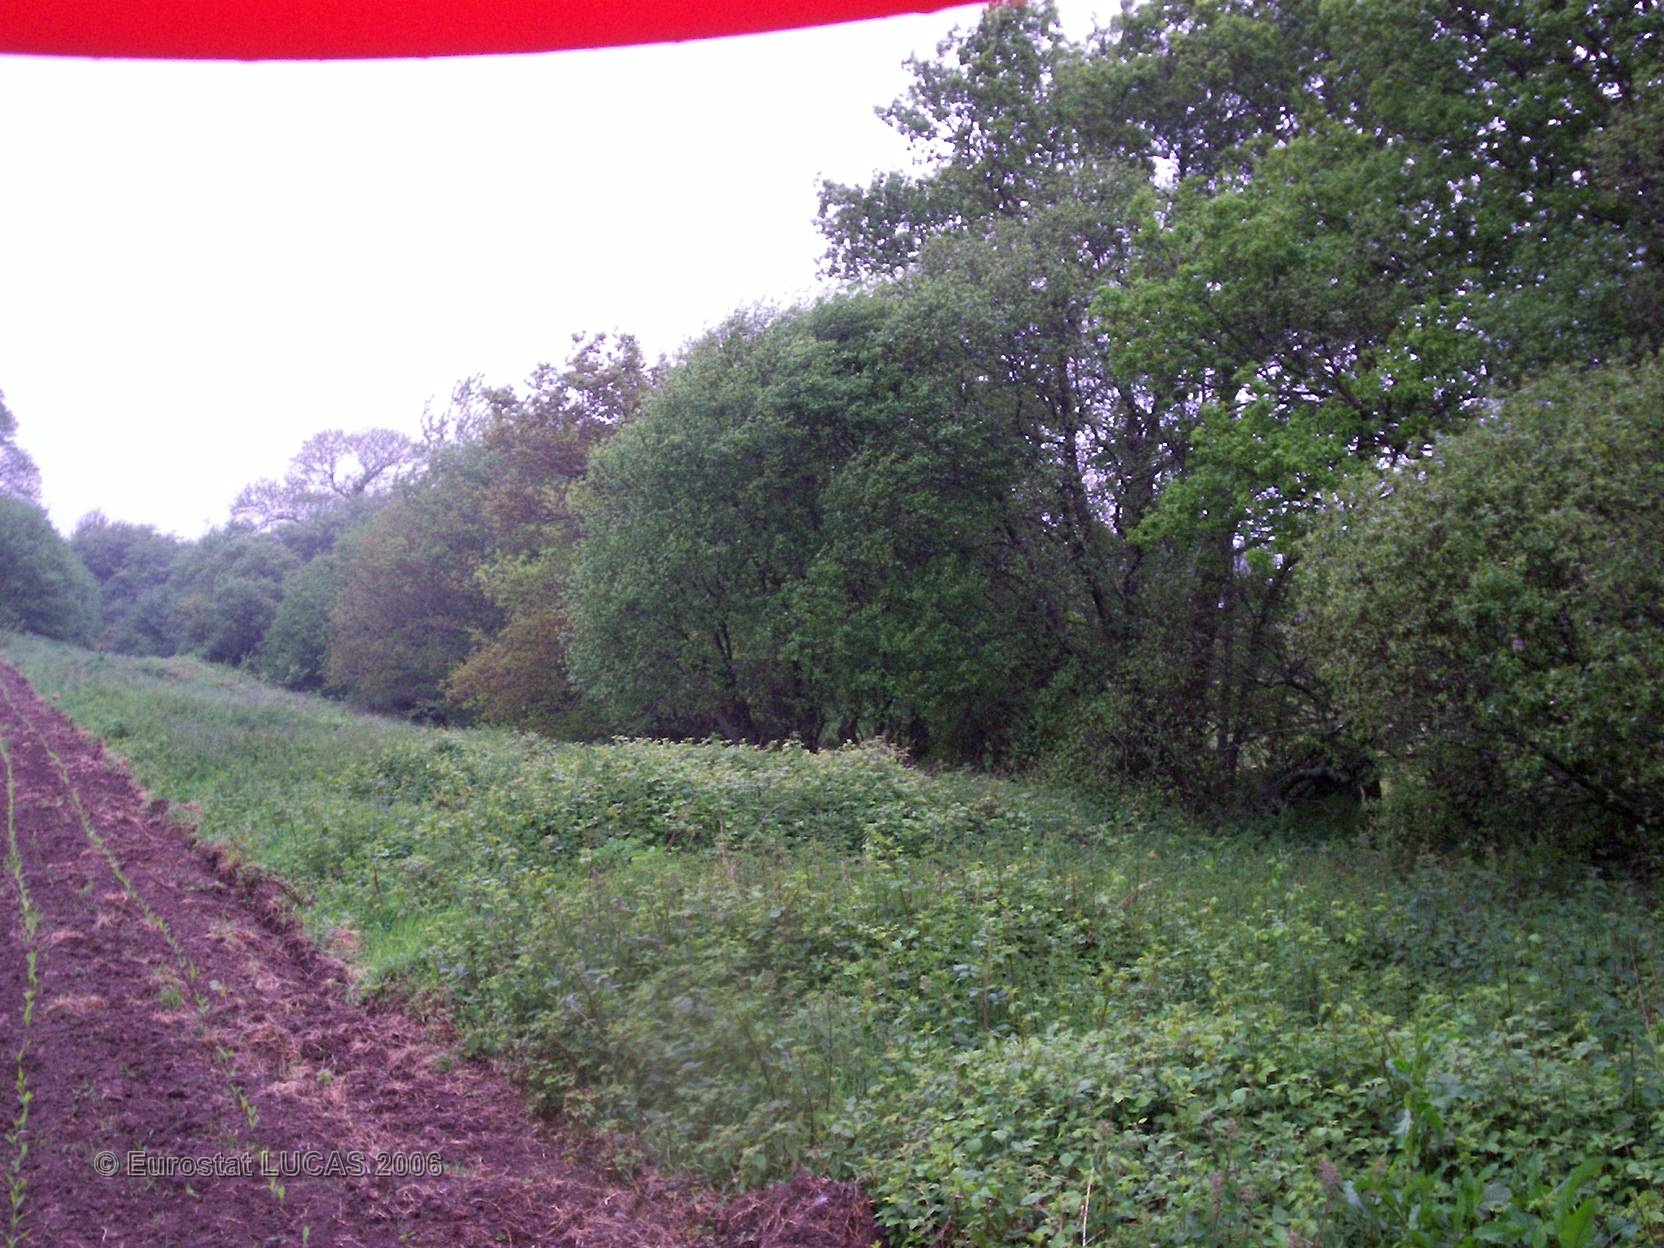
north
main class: Cropland
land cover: Maize
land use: Agriculture (excluding fallow land and kitchen gardens)
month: May
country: FR
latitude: 47.9099
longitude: -3.8501
